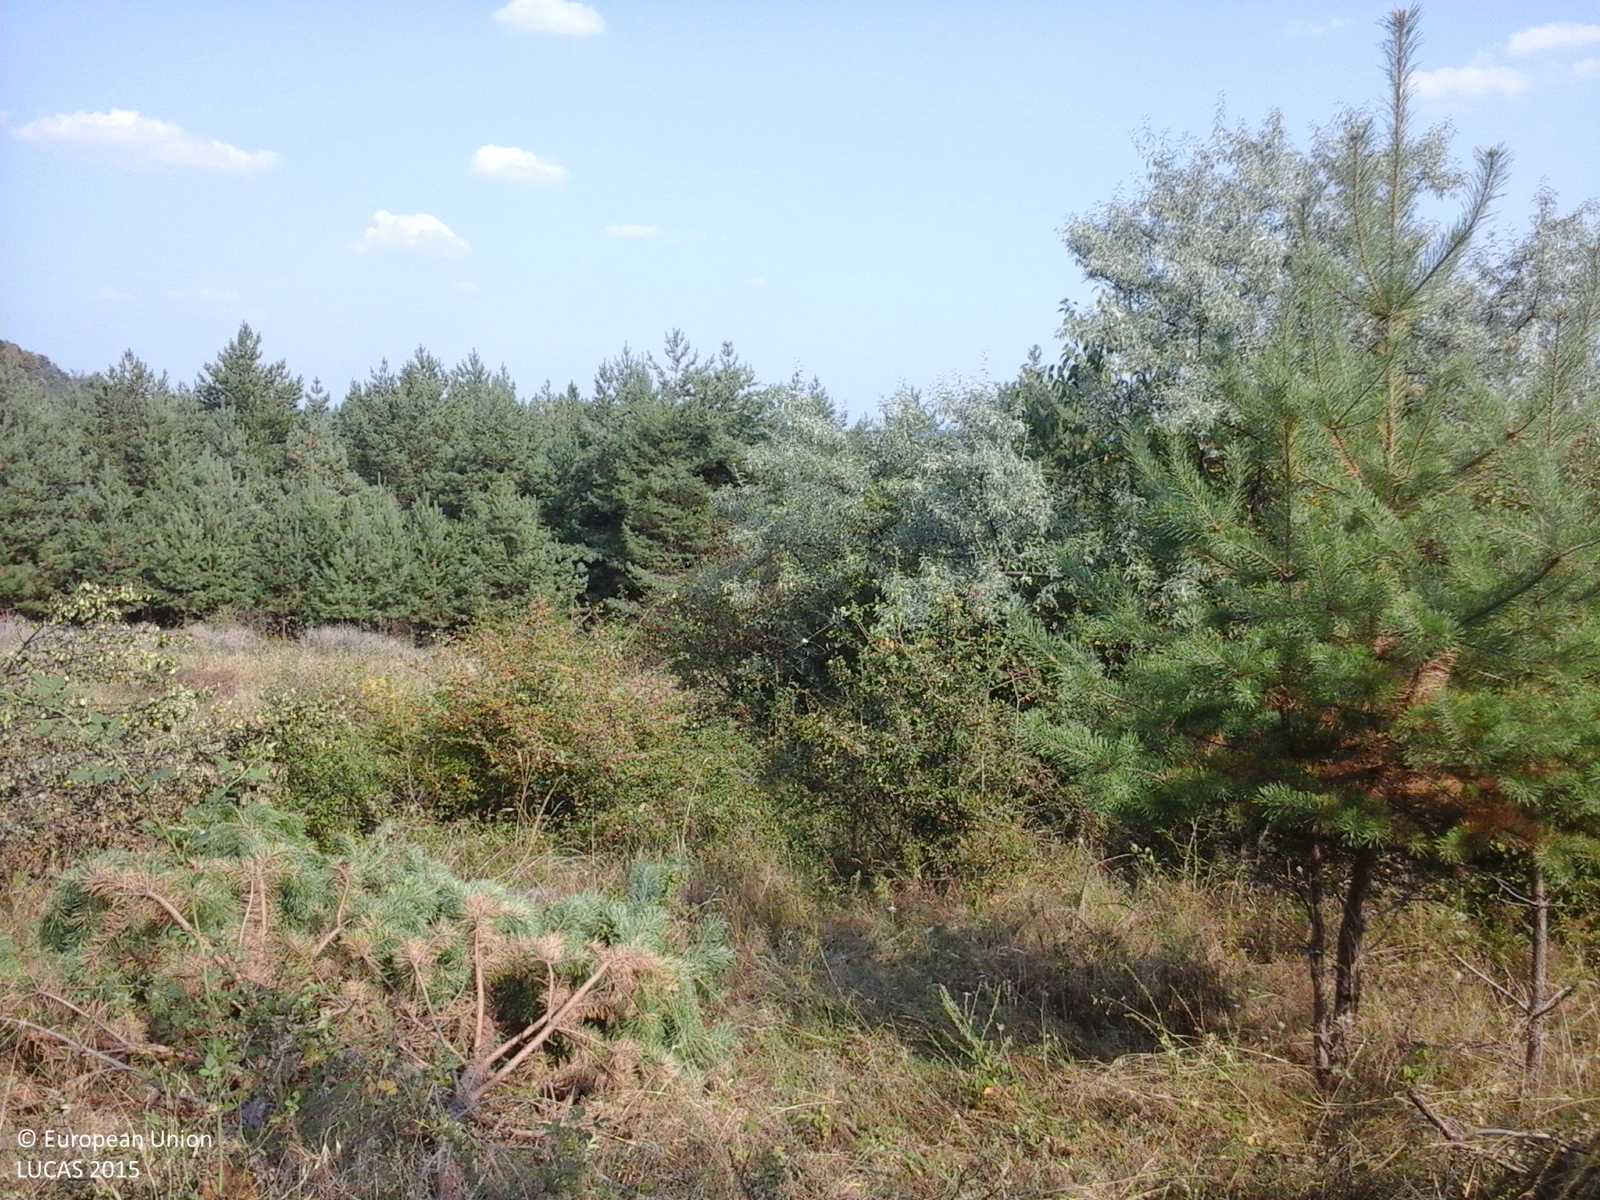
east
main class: Grassland
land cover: Grassland with sparse tree/shrub cover
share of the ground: > 75 %
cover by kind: herbaceous plants 85 %, shrubs 10 %, broadleaved forest trees 5 %
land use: Forestry
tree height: < 5 m
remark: Clear cut
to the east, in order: Grassland with sparse tree/shrub cover; Tracks; Other mixed woodland
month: September
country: RO
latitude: 47.1226
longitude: 24.1482
